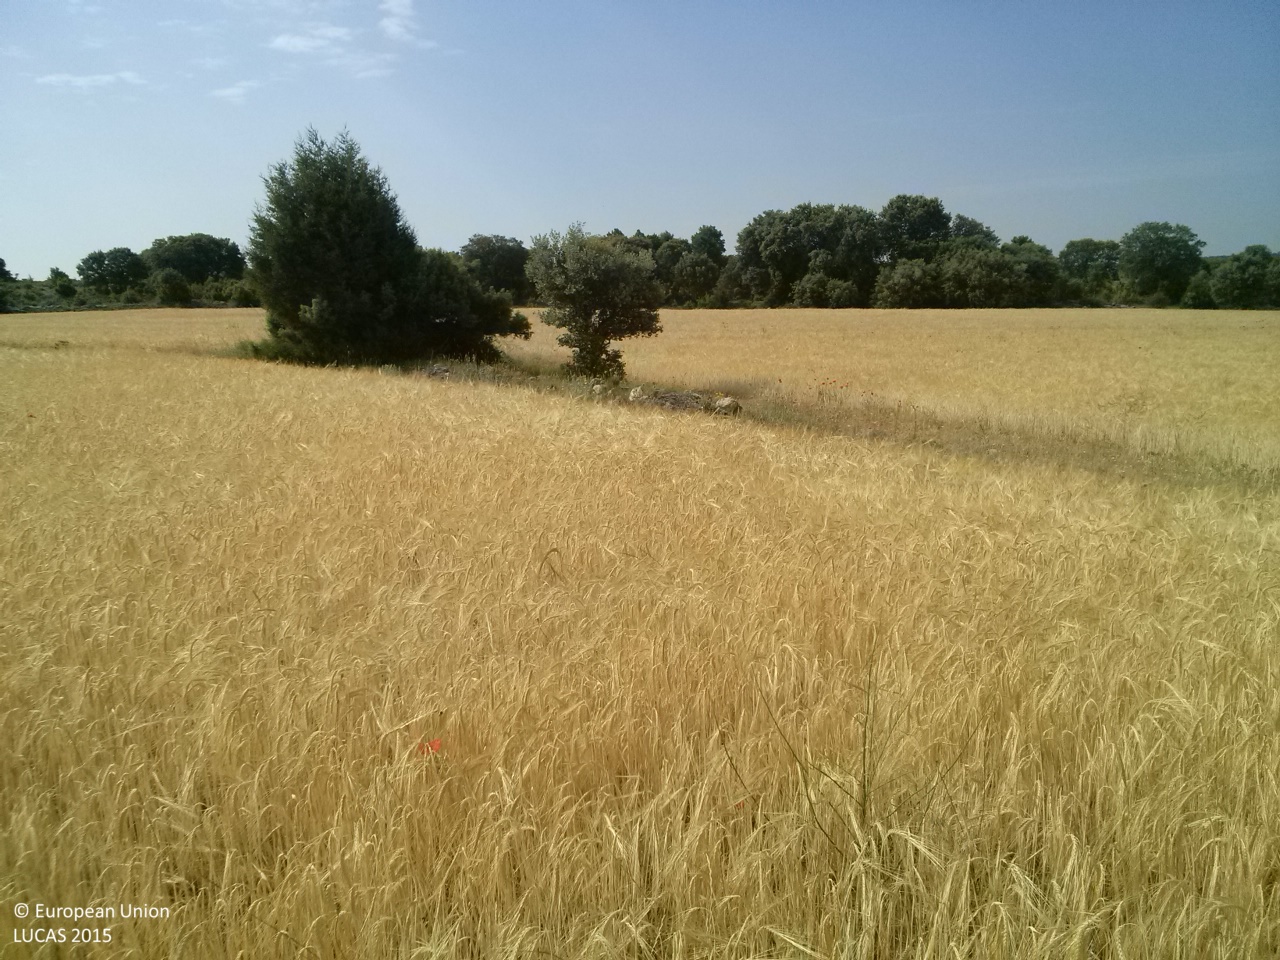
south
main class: Cropland
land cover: Barley
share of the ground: > 75 %
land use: Agriculture (excluding fallow land and kitchen gardens)
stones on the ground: 25 - 50 %
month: June
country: ES
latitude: 39.9583
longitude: -1.9177
